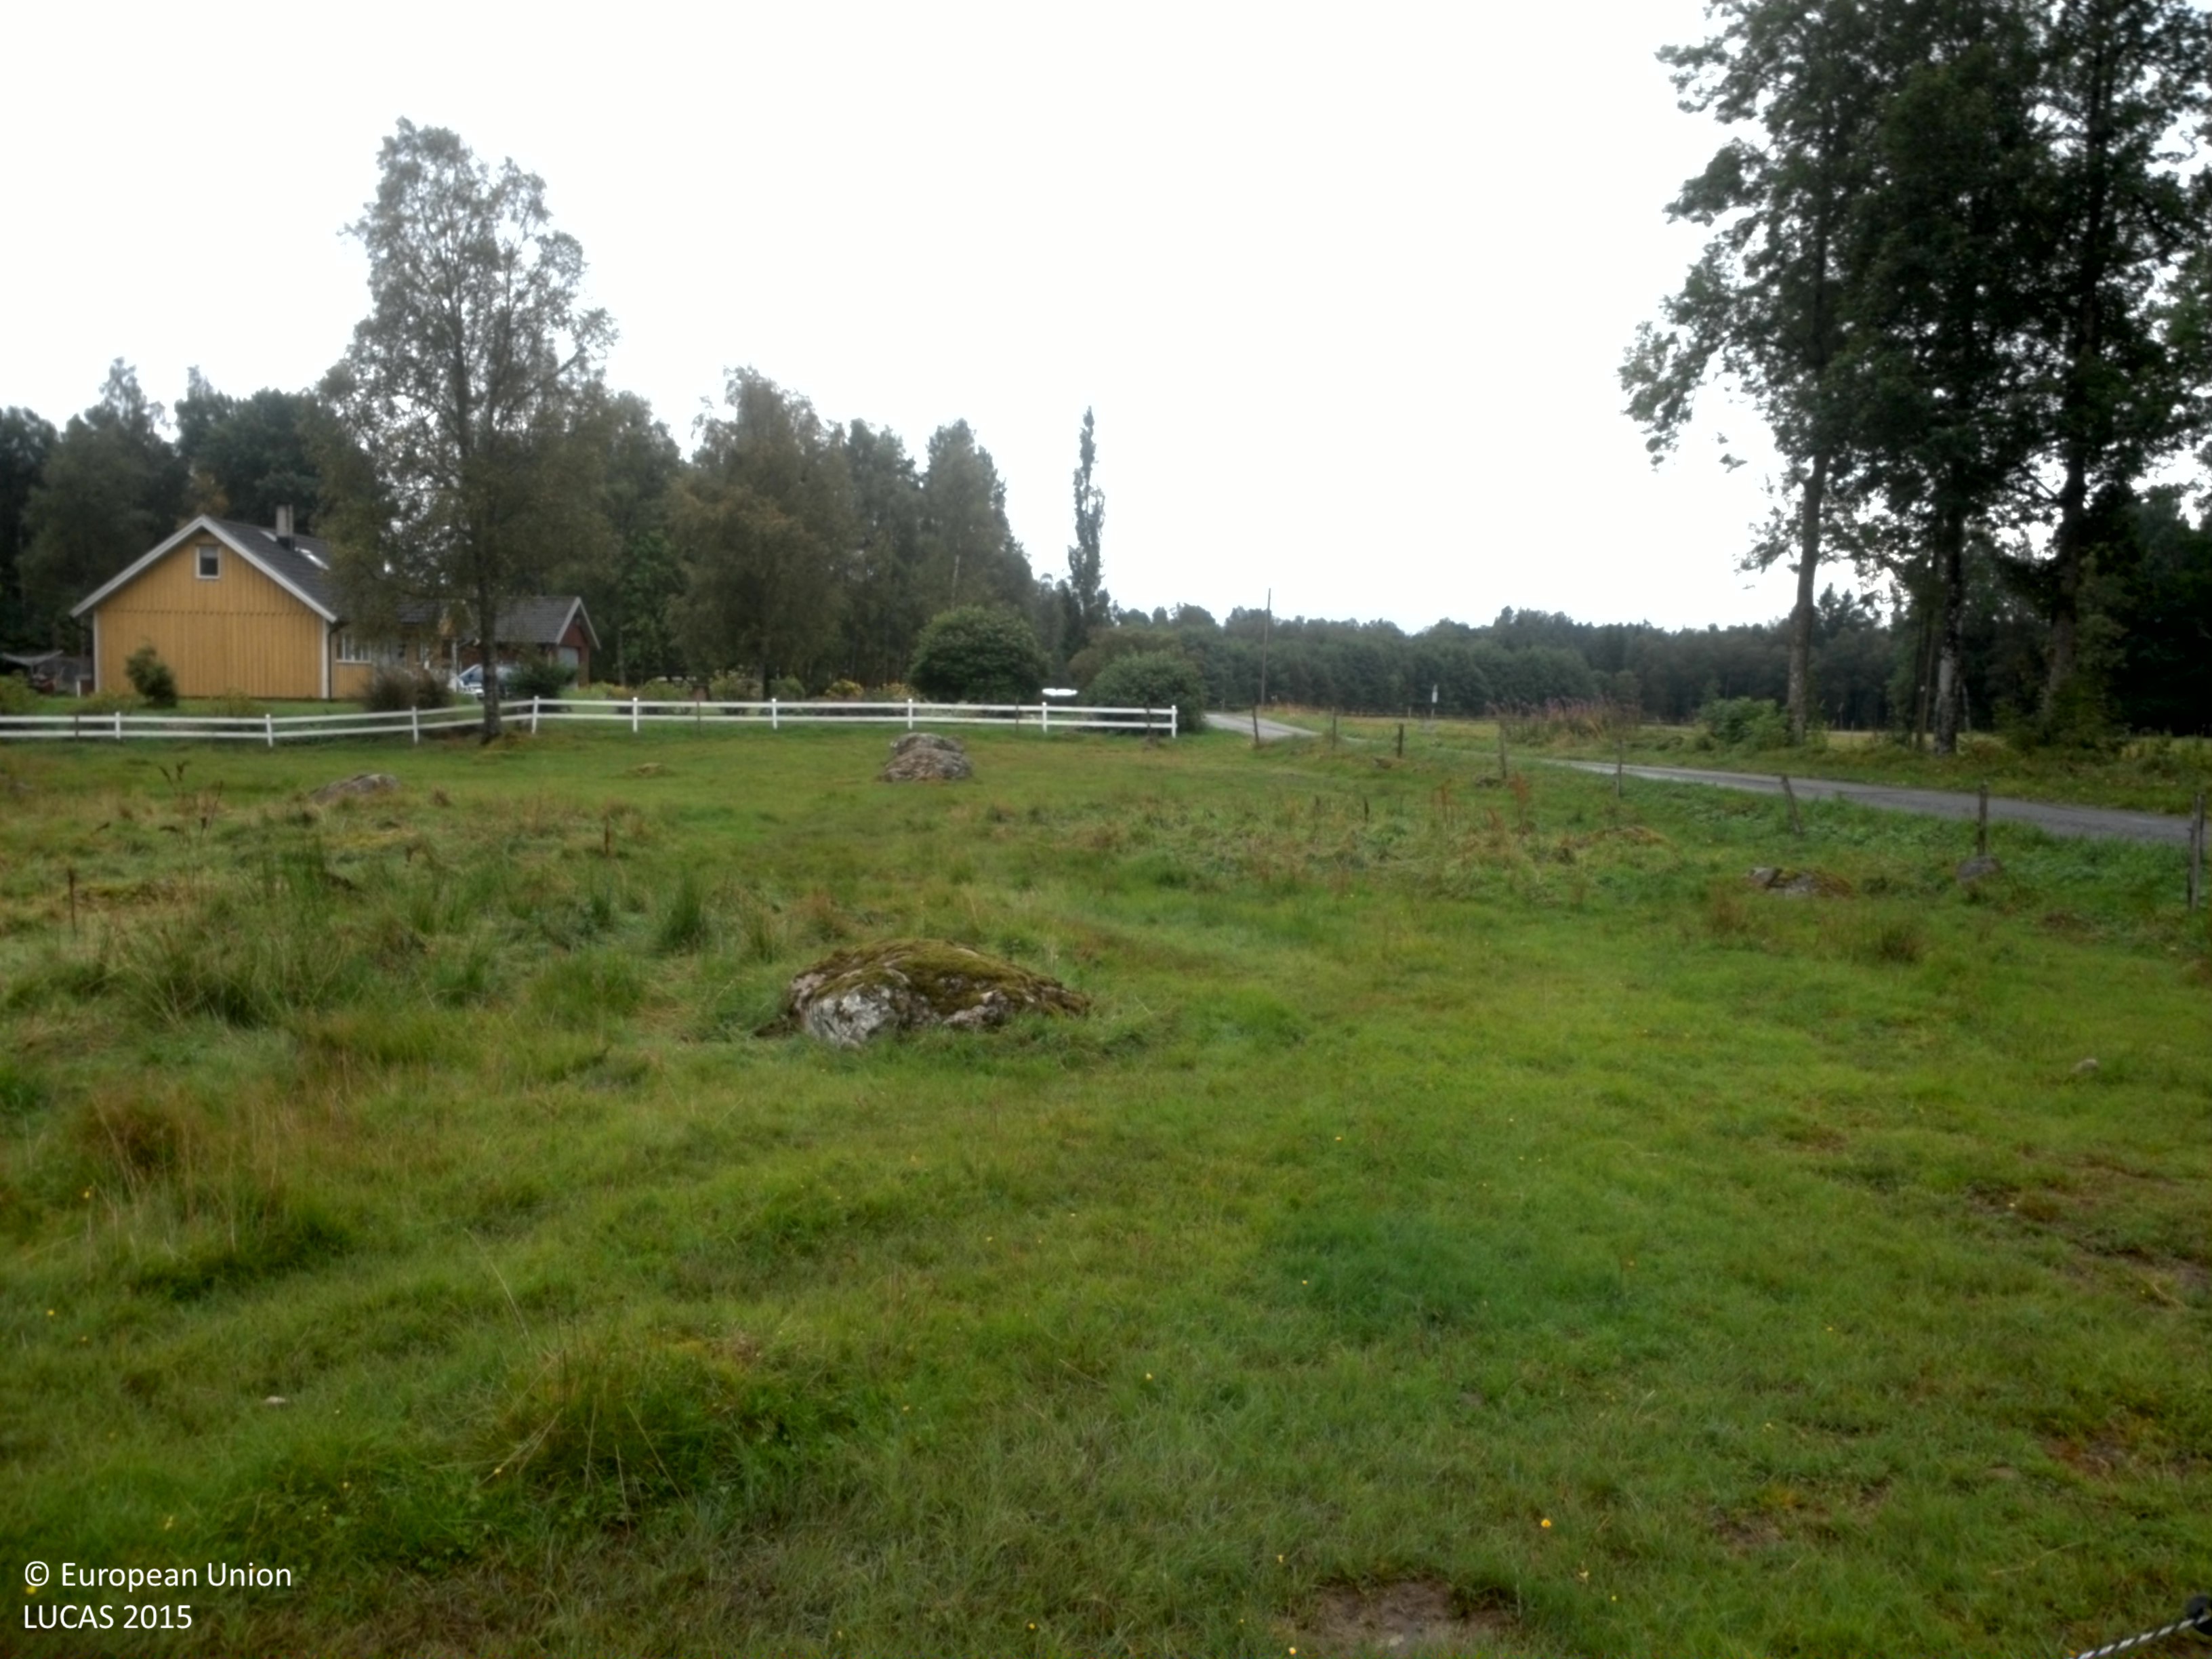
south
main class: Cropland
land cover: Temporary grasslands
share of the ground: > 75 %
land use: Agriculture (excluding fallow land and kitchen gardens)
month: August
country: SE
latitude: 57.8415
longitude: 13.1116
